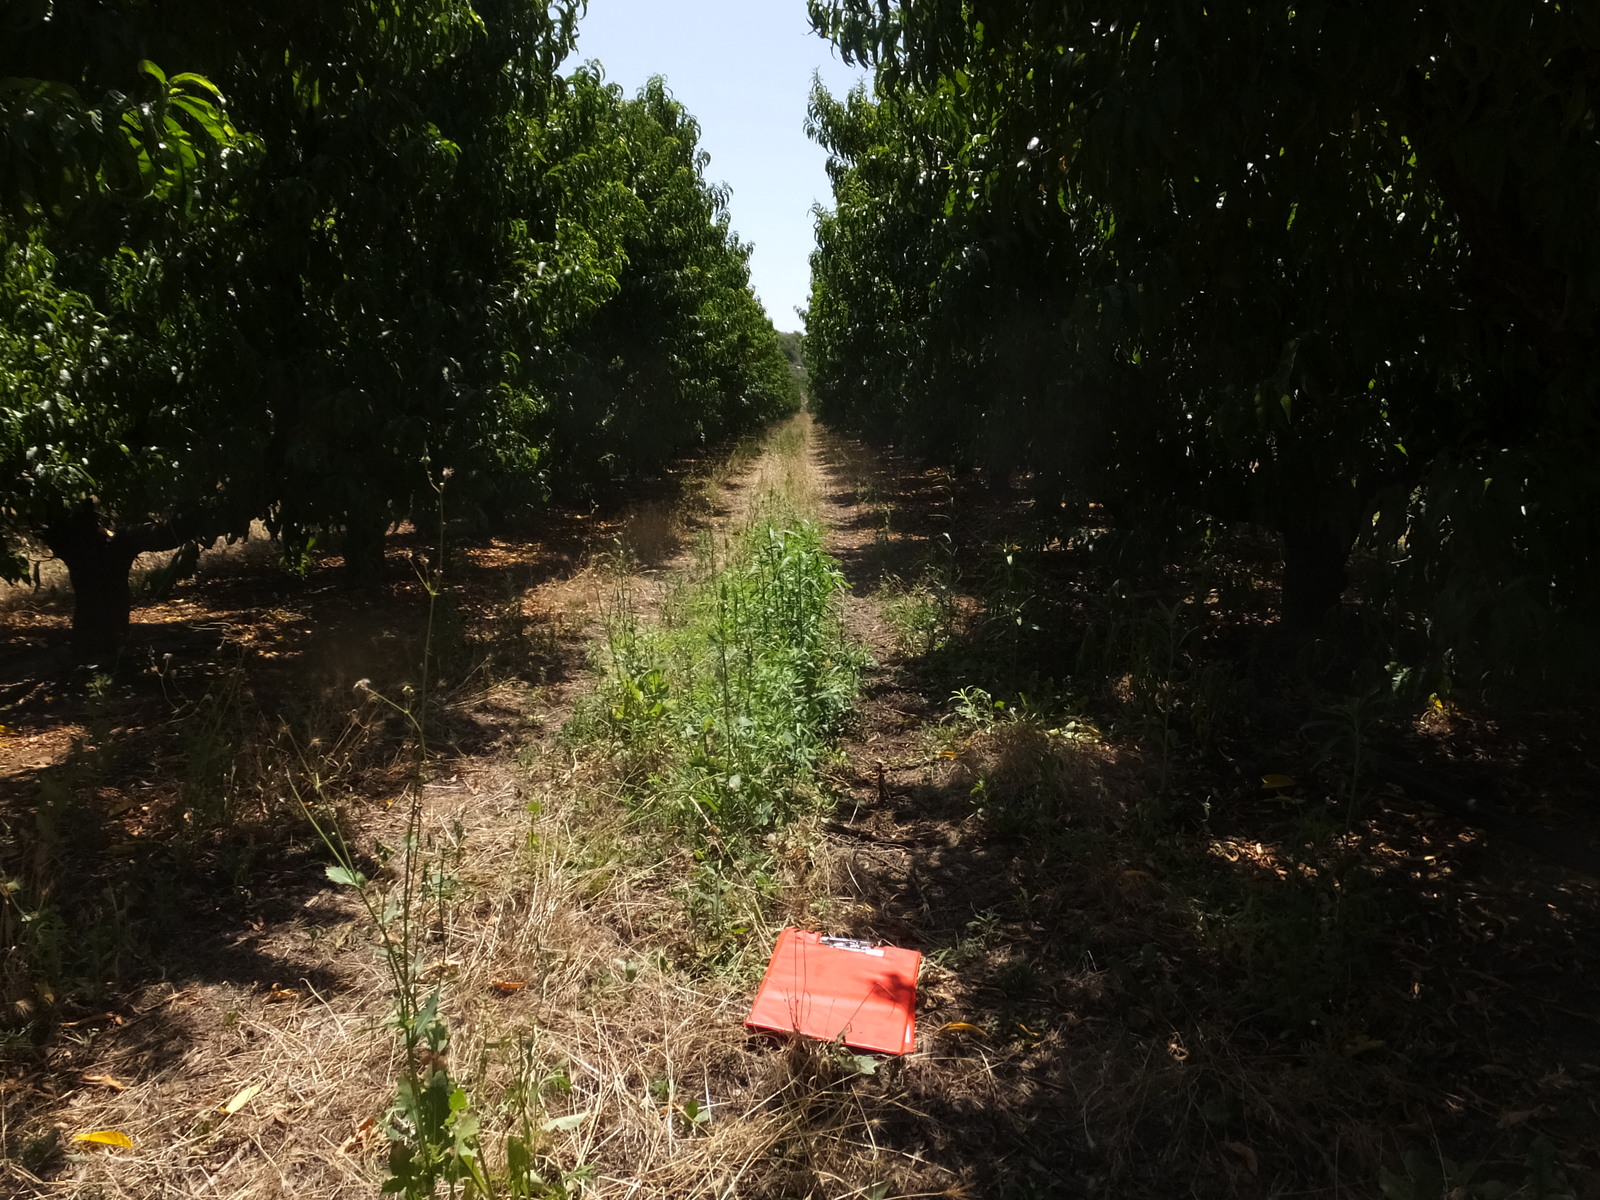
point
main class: Cropland
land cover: Other fruit trees and berries
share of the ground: 50 - 75 %
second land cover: Other bare soil
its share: > 75 %
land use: Agriculture (excluding fallow land and kitchen gardens)
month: July
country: ES
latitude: 41.4584
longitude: 0.4706
